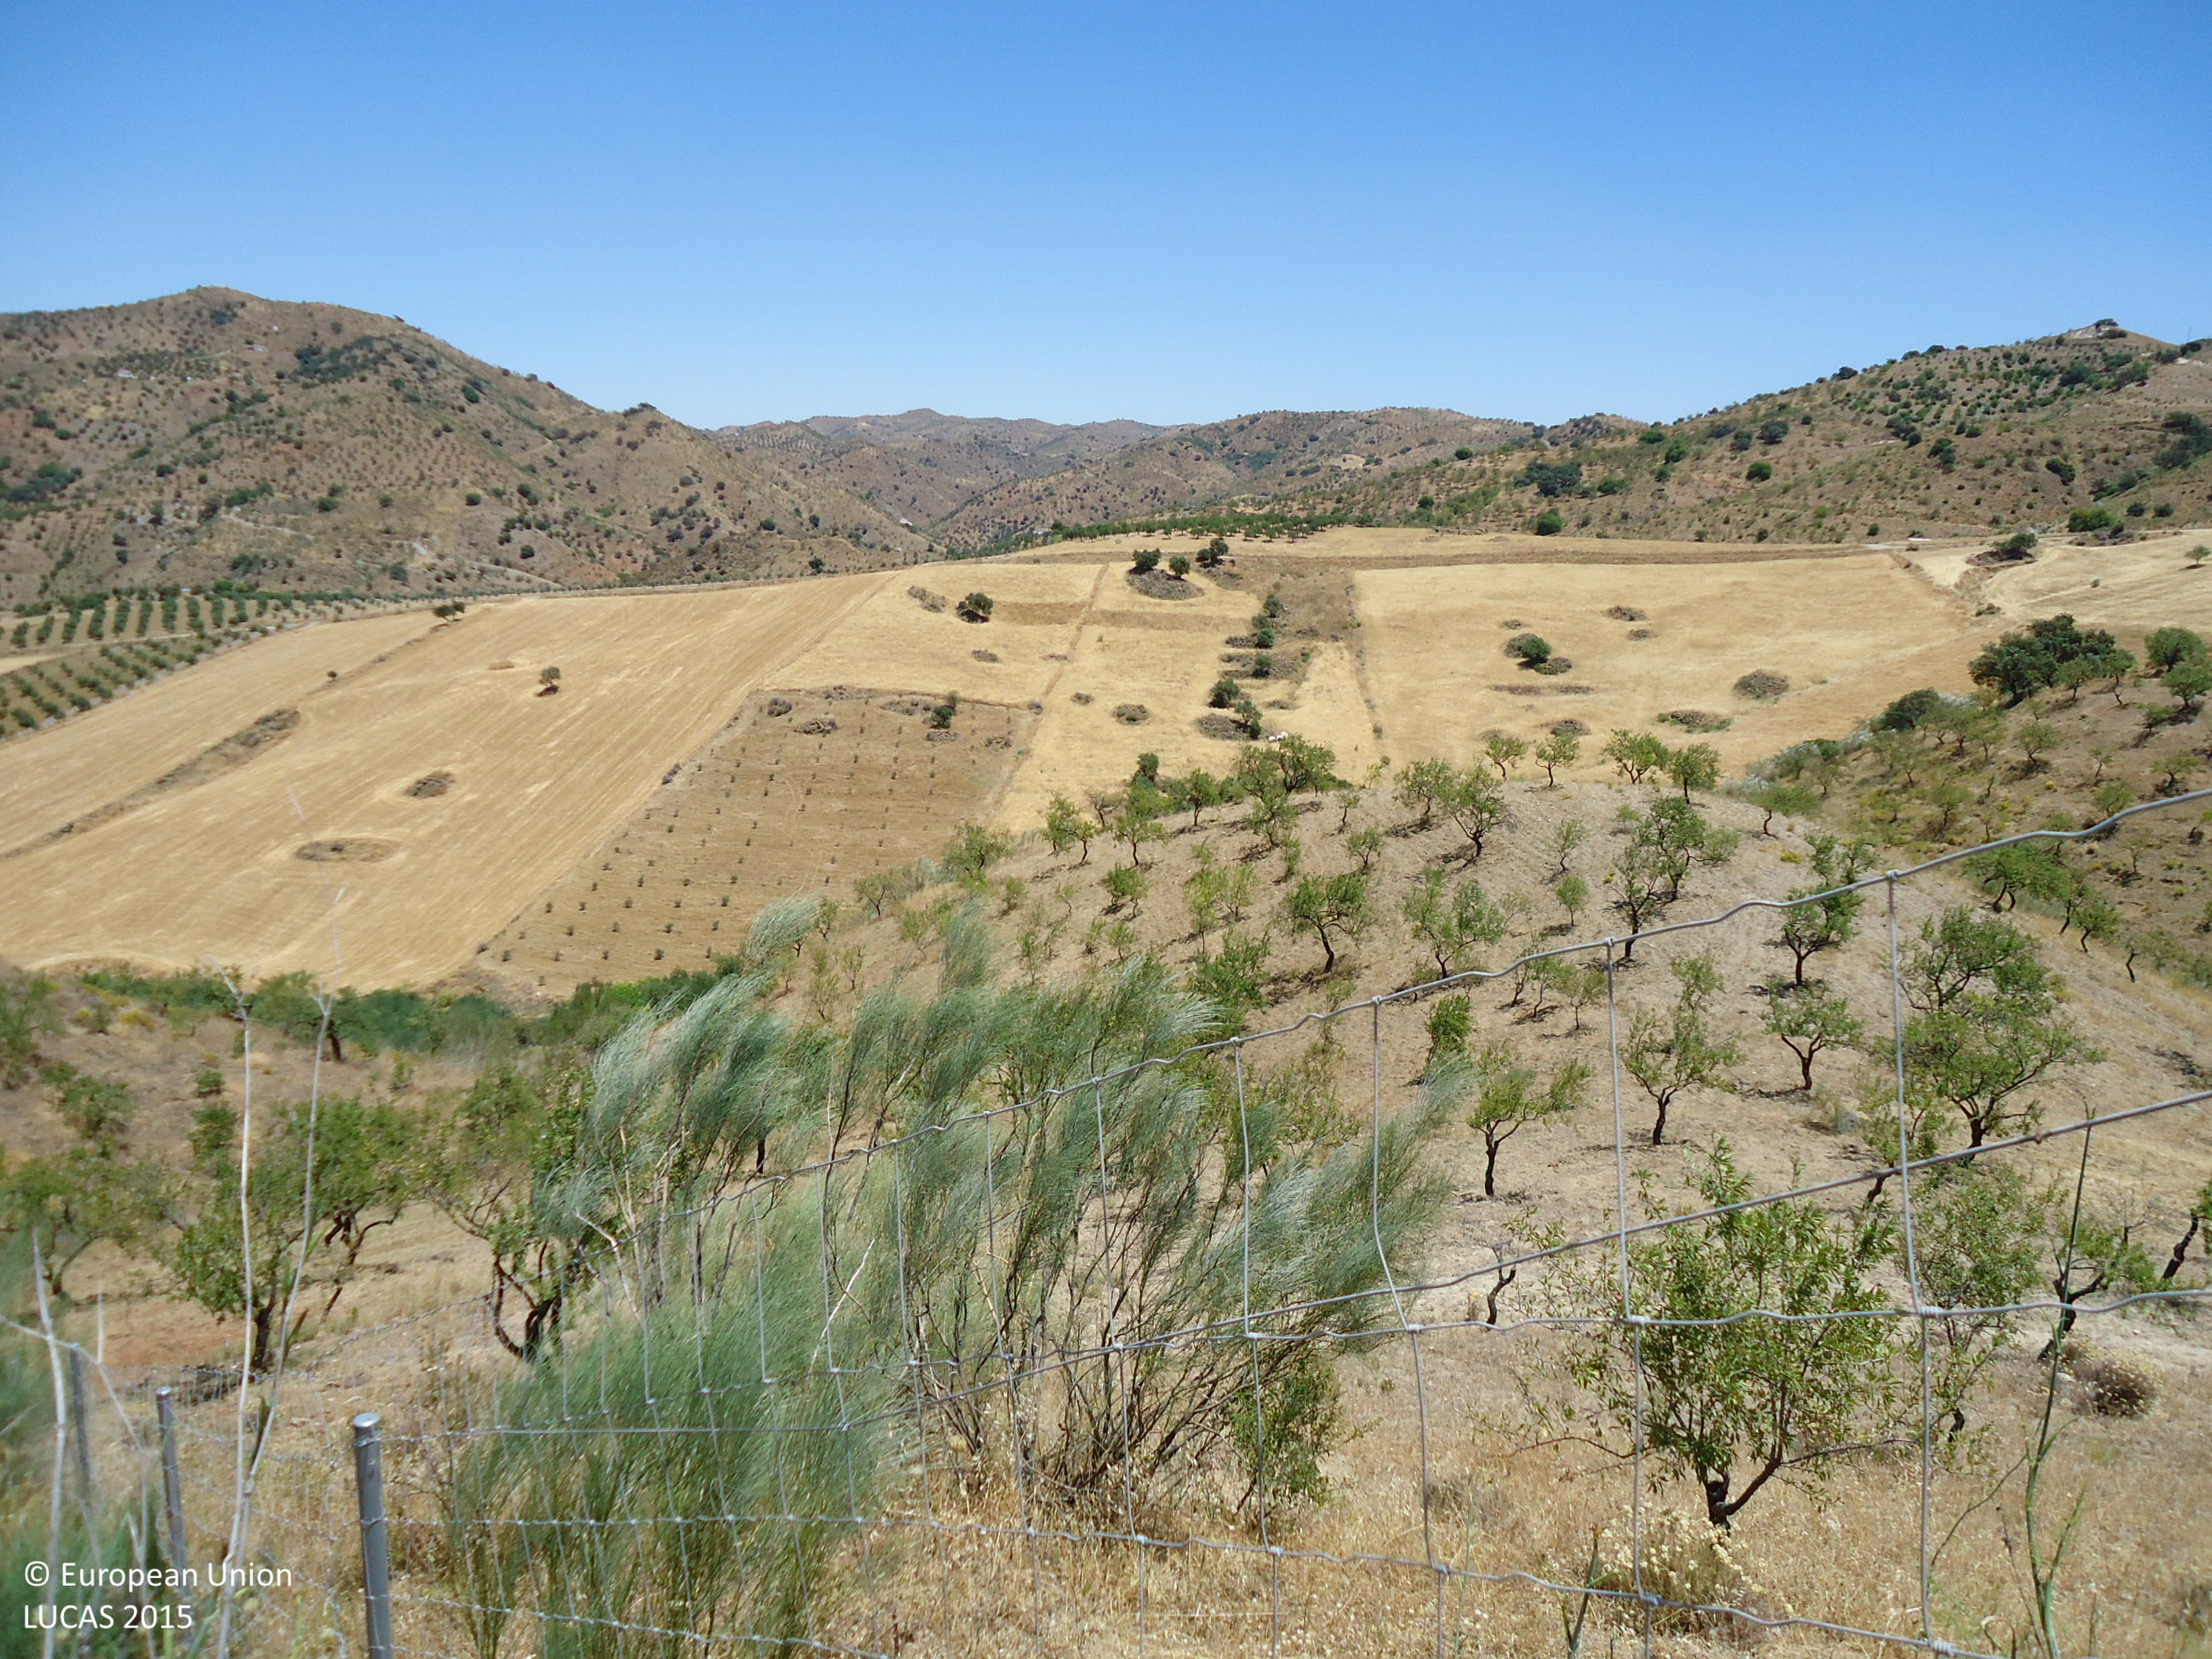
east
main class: Cropland
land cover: Nuts trees
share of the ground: 25 - 50 %
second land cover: Other bare soil
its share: > 75 %
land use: Agriculture (excluding fallow land and kitchen gardens)
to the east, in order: Nuts trees; Other bare soil; Olive groves; Spontaneously vegetated surfaces
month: June
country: ES
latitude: 36.7848
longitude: -4.6844
